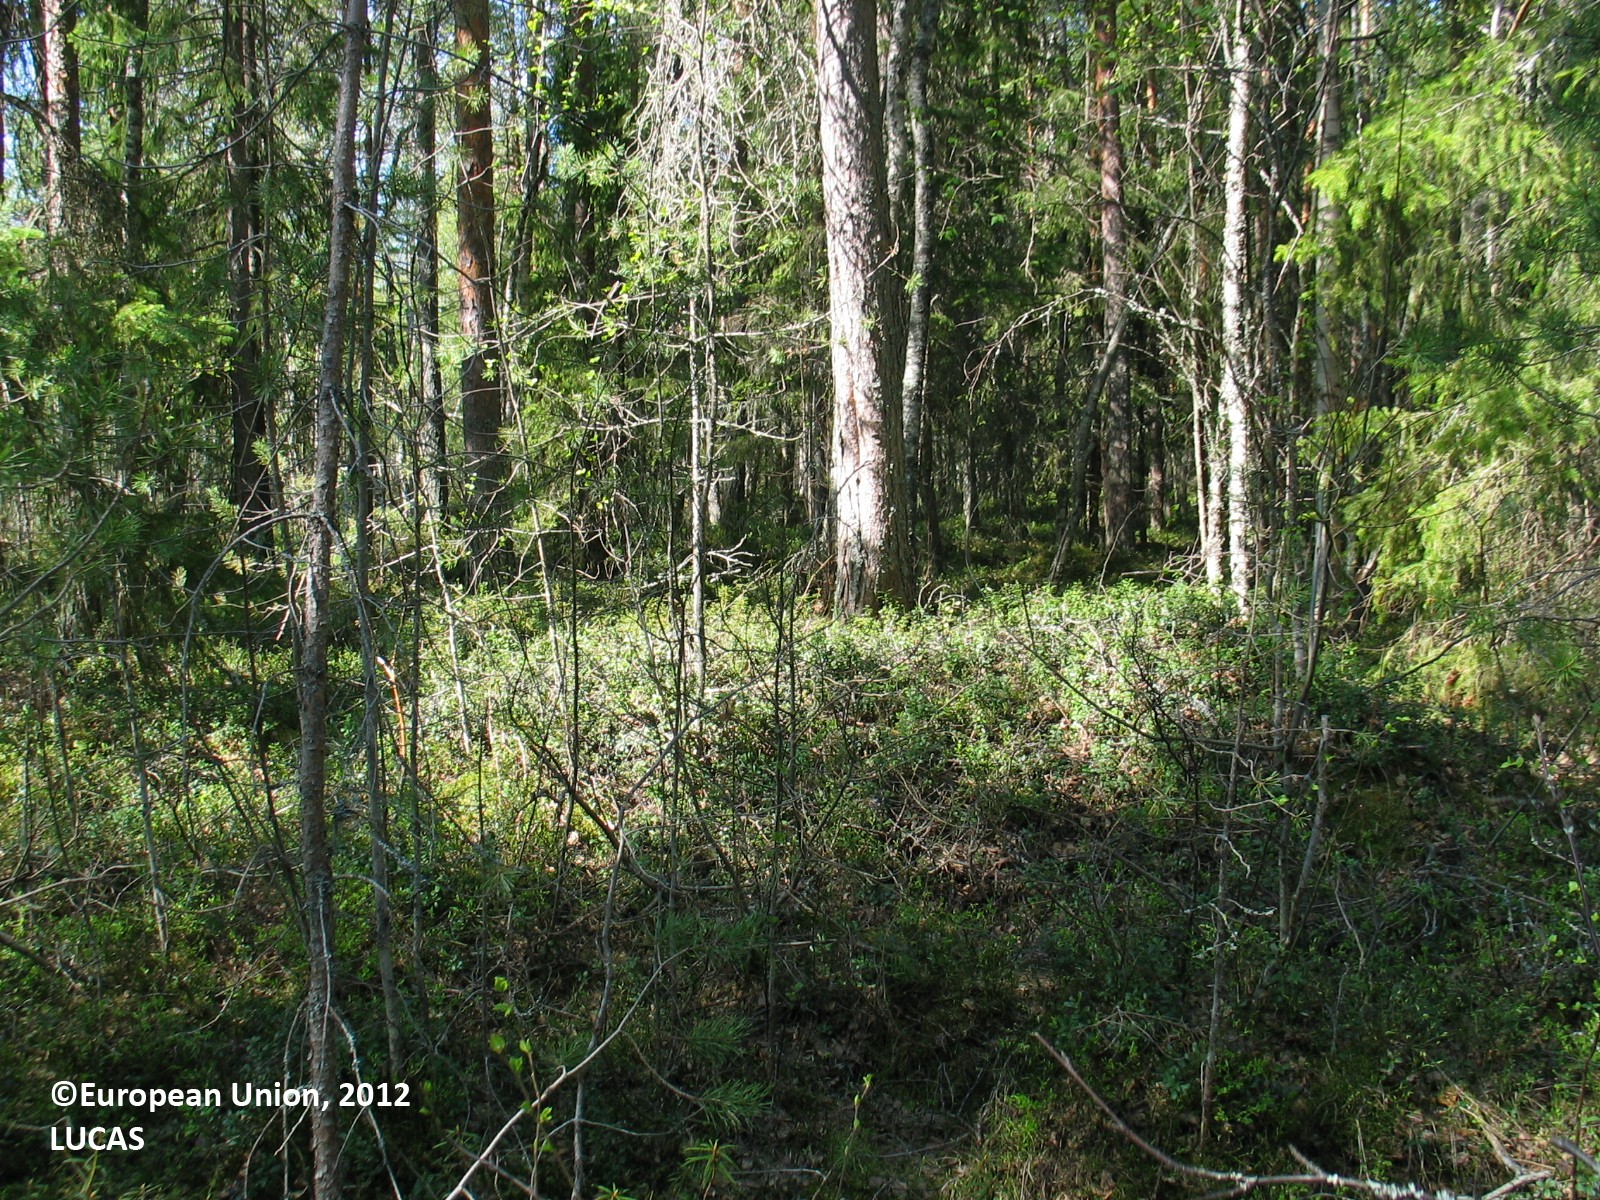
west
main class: Woodland
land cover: Other mixed woodland
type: mire and swamp forests
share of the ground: 50 - 75 %
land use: Forestry
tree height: > 5 m
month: May
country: FI
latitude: 64.9654
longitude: 25.2647
